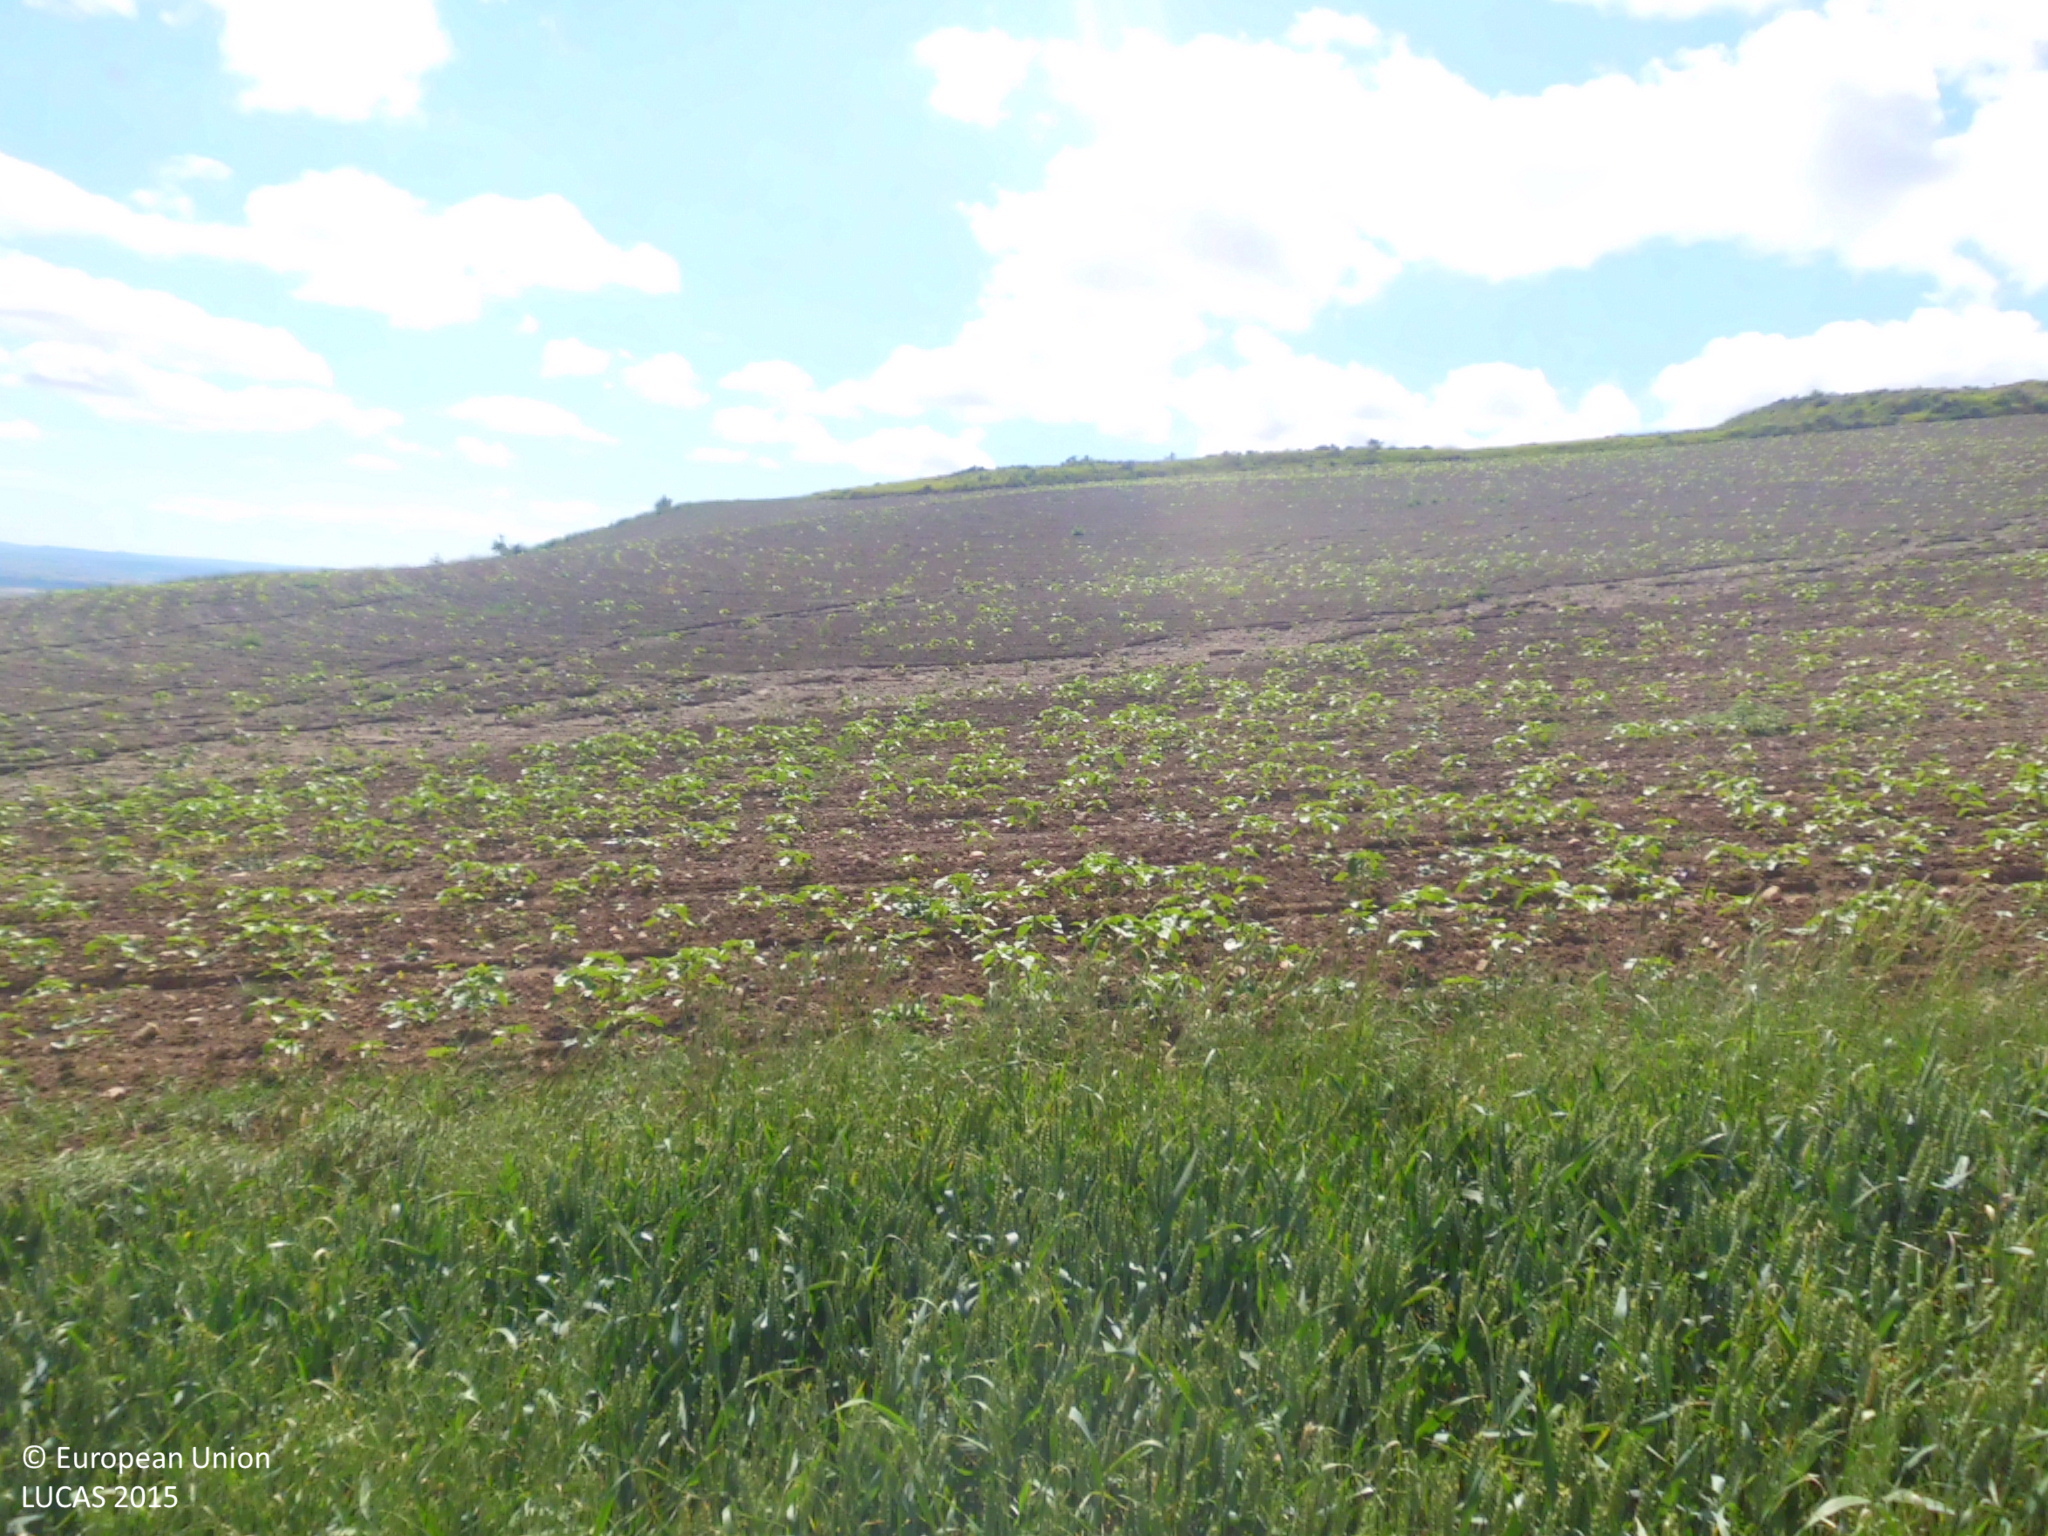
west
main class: Cropland
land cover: Common wheat
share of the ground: > 75 %
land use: Agriculture (excluding fallow land and kitchen gardens)
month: June
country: ES
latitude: 42.6863
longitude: -3.3005
